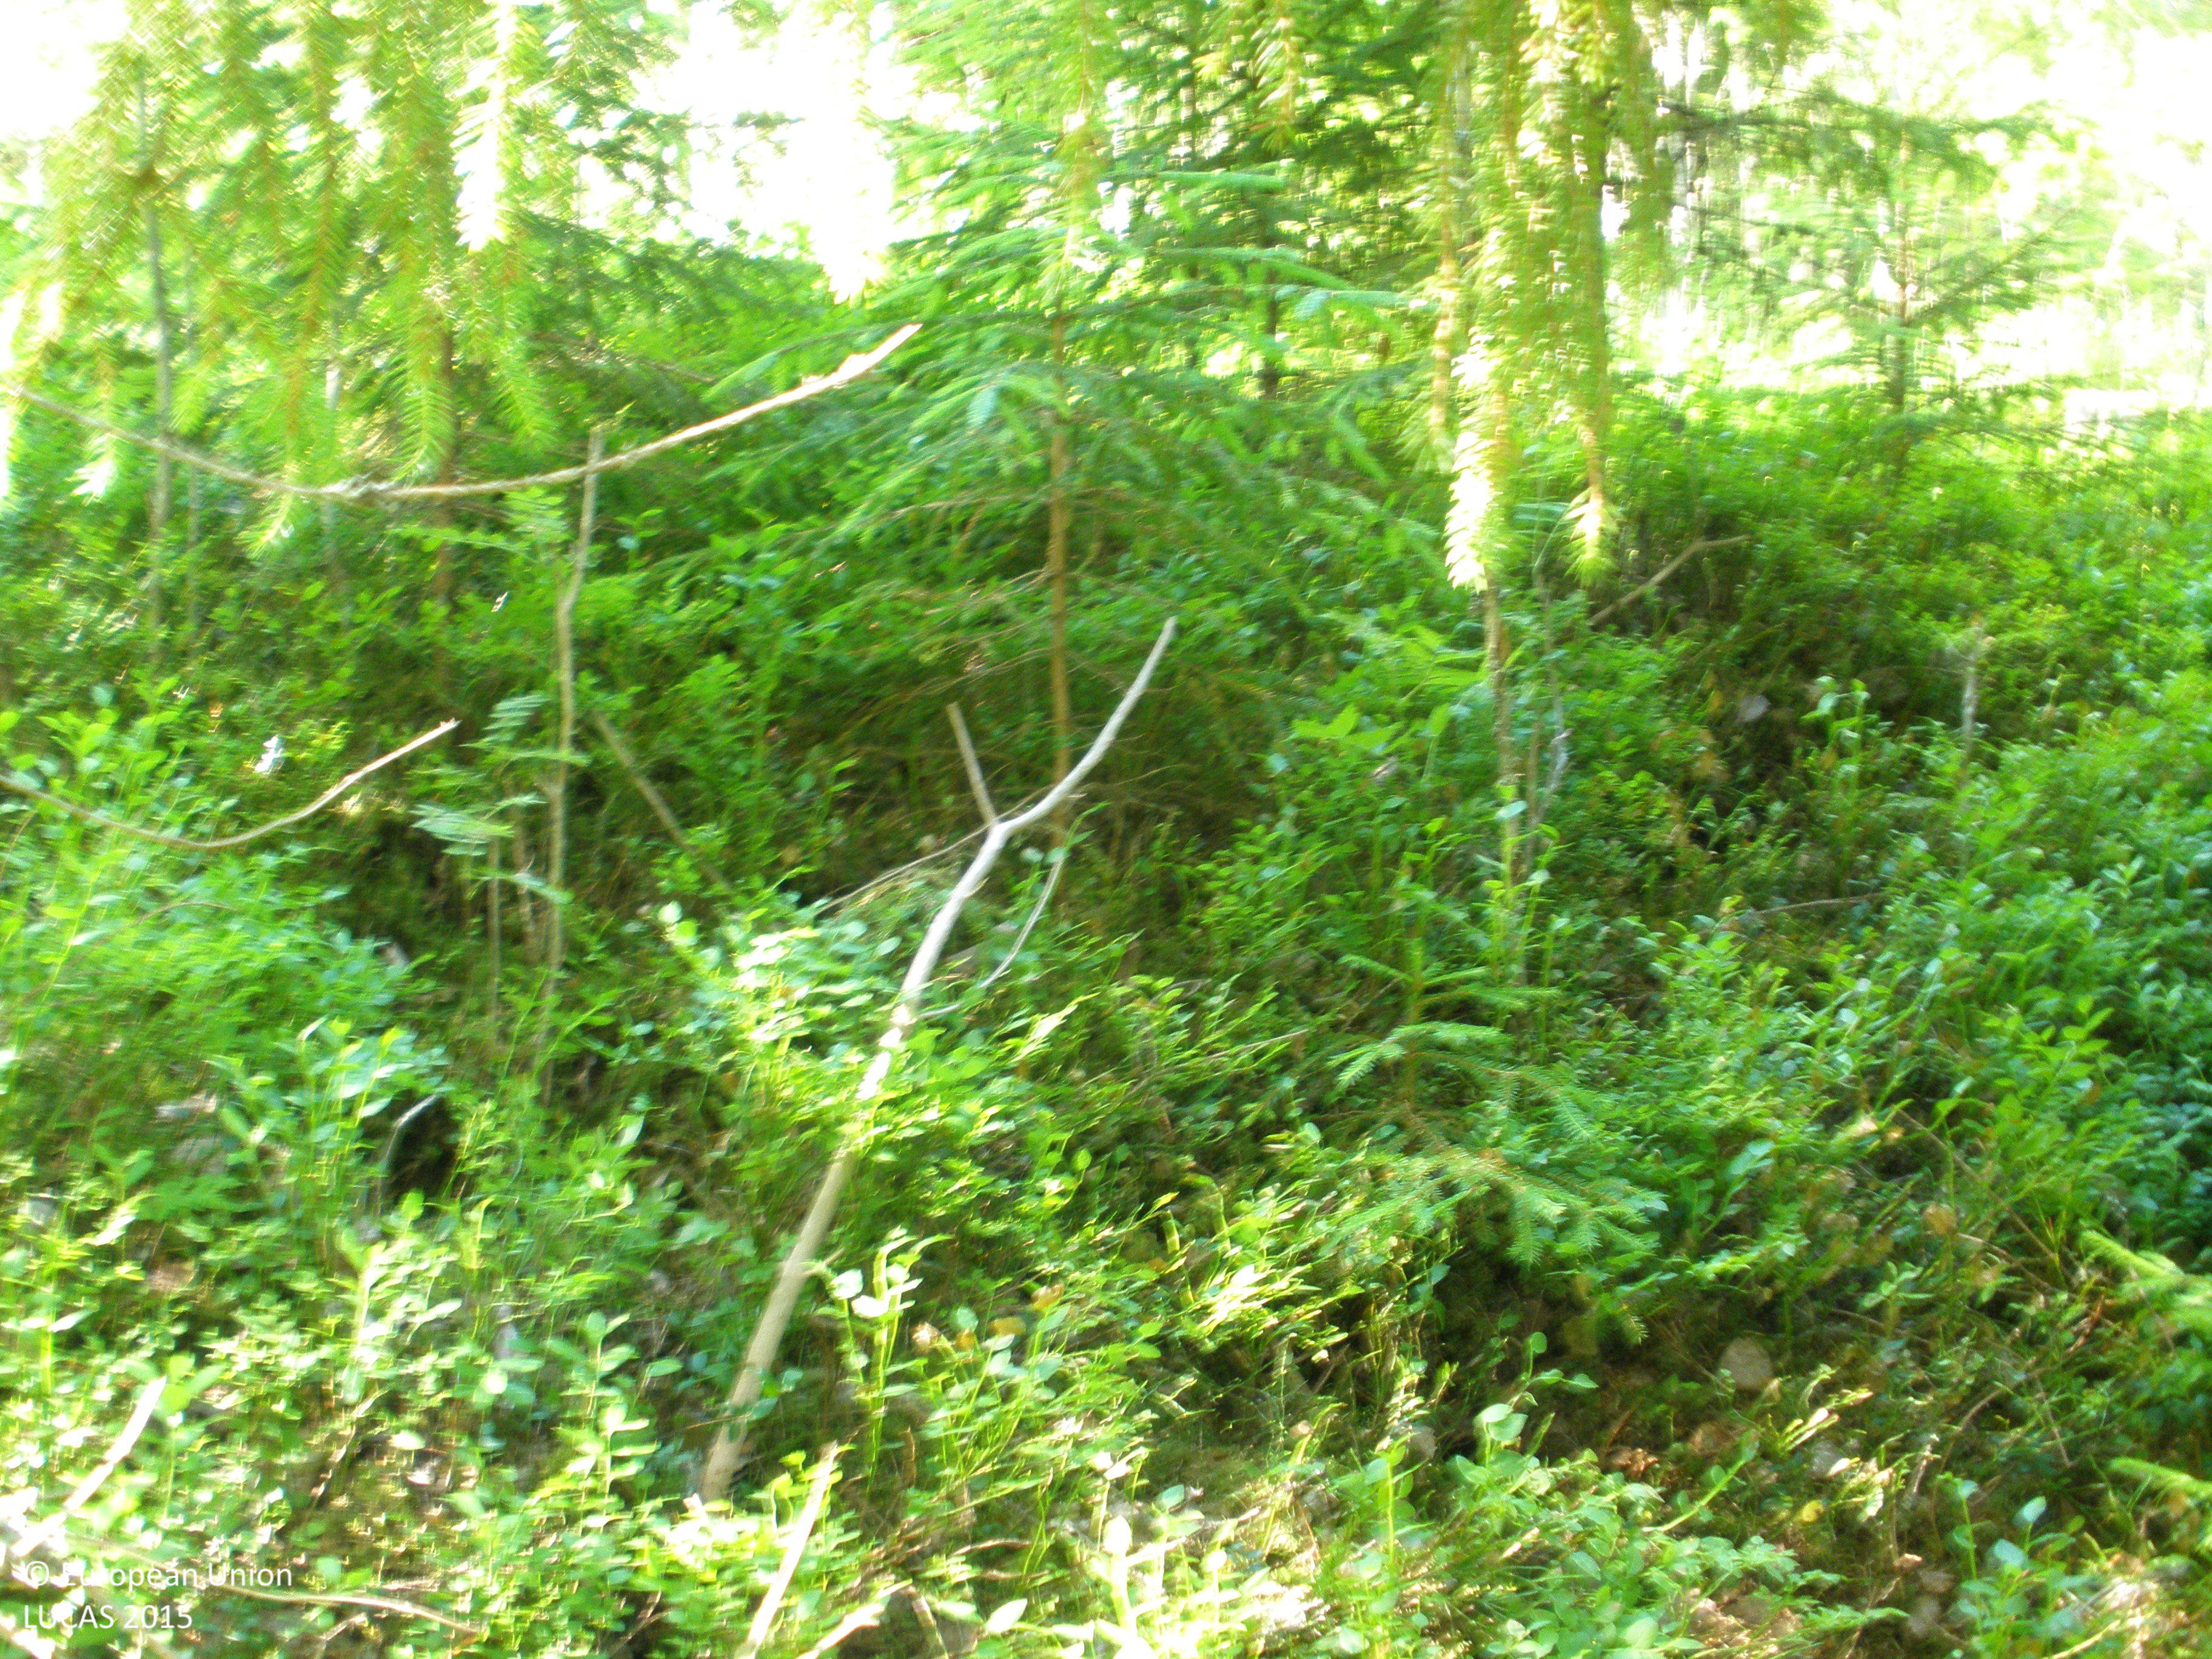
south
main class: Woodland
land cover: Spruce dominated mixed woodland
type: boreal forest
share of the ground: > 75 %
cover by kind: coniferous forest trees 60 %, broadleaved forest trees 25 %, herbaceous plants 10 %, lichens and mosses 5 %
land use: Forestry
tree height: > 5 m
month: July
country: FI
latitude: 61.2018
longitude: 23.6124
